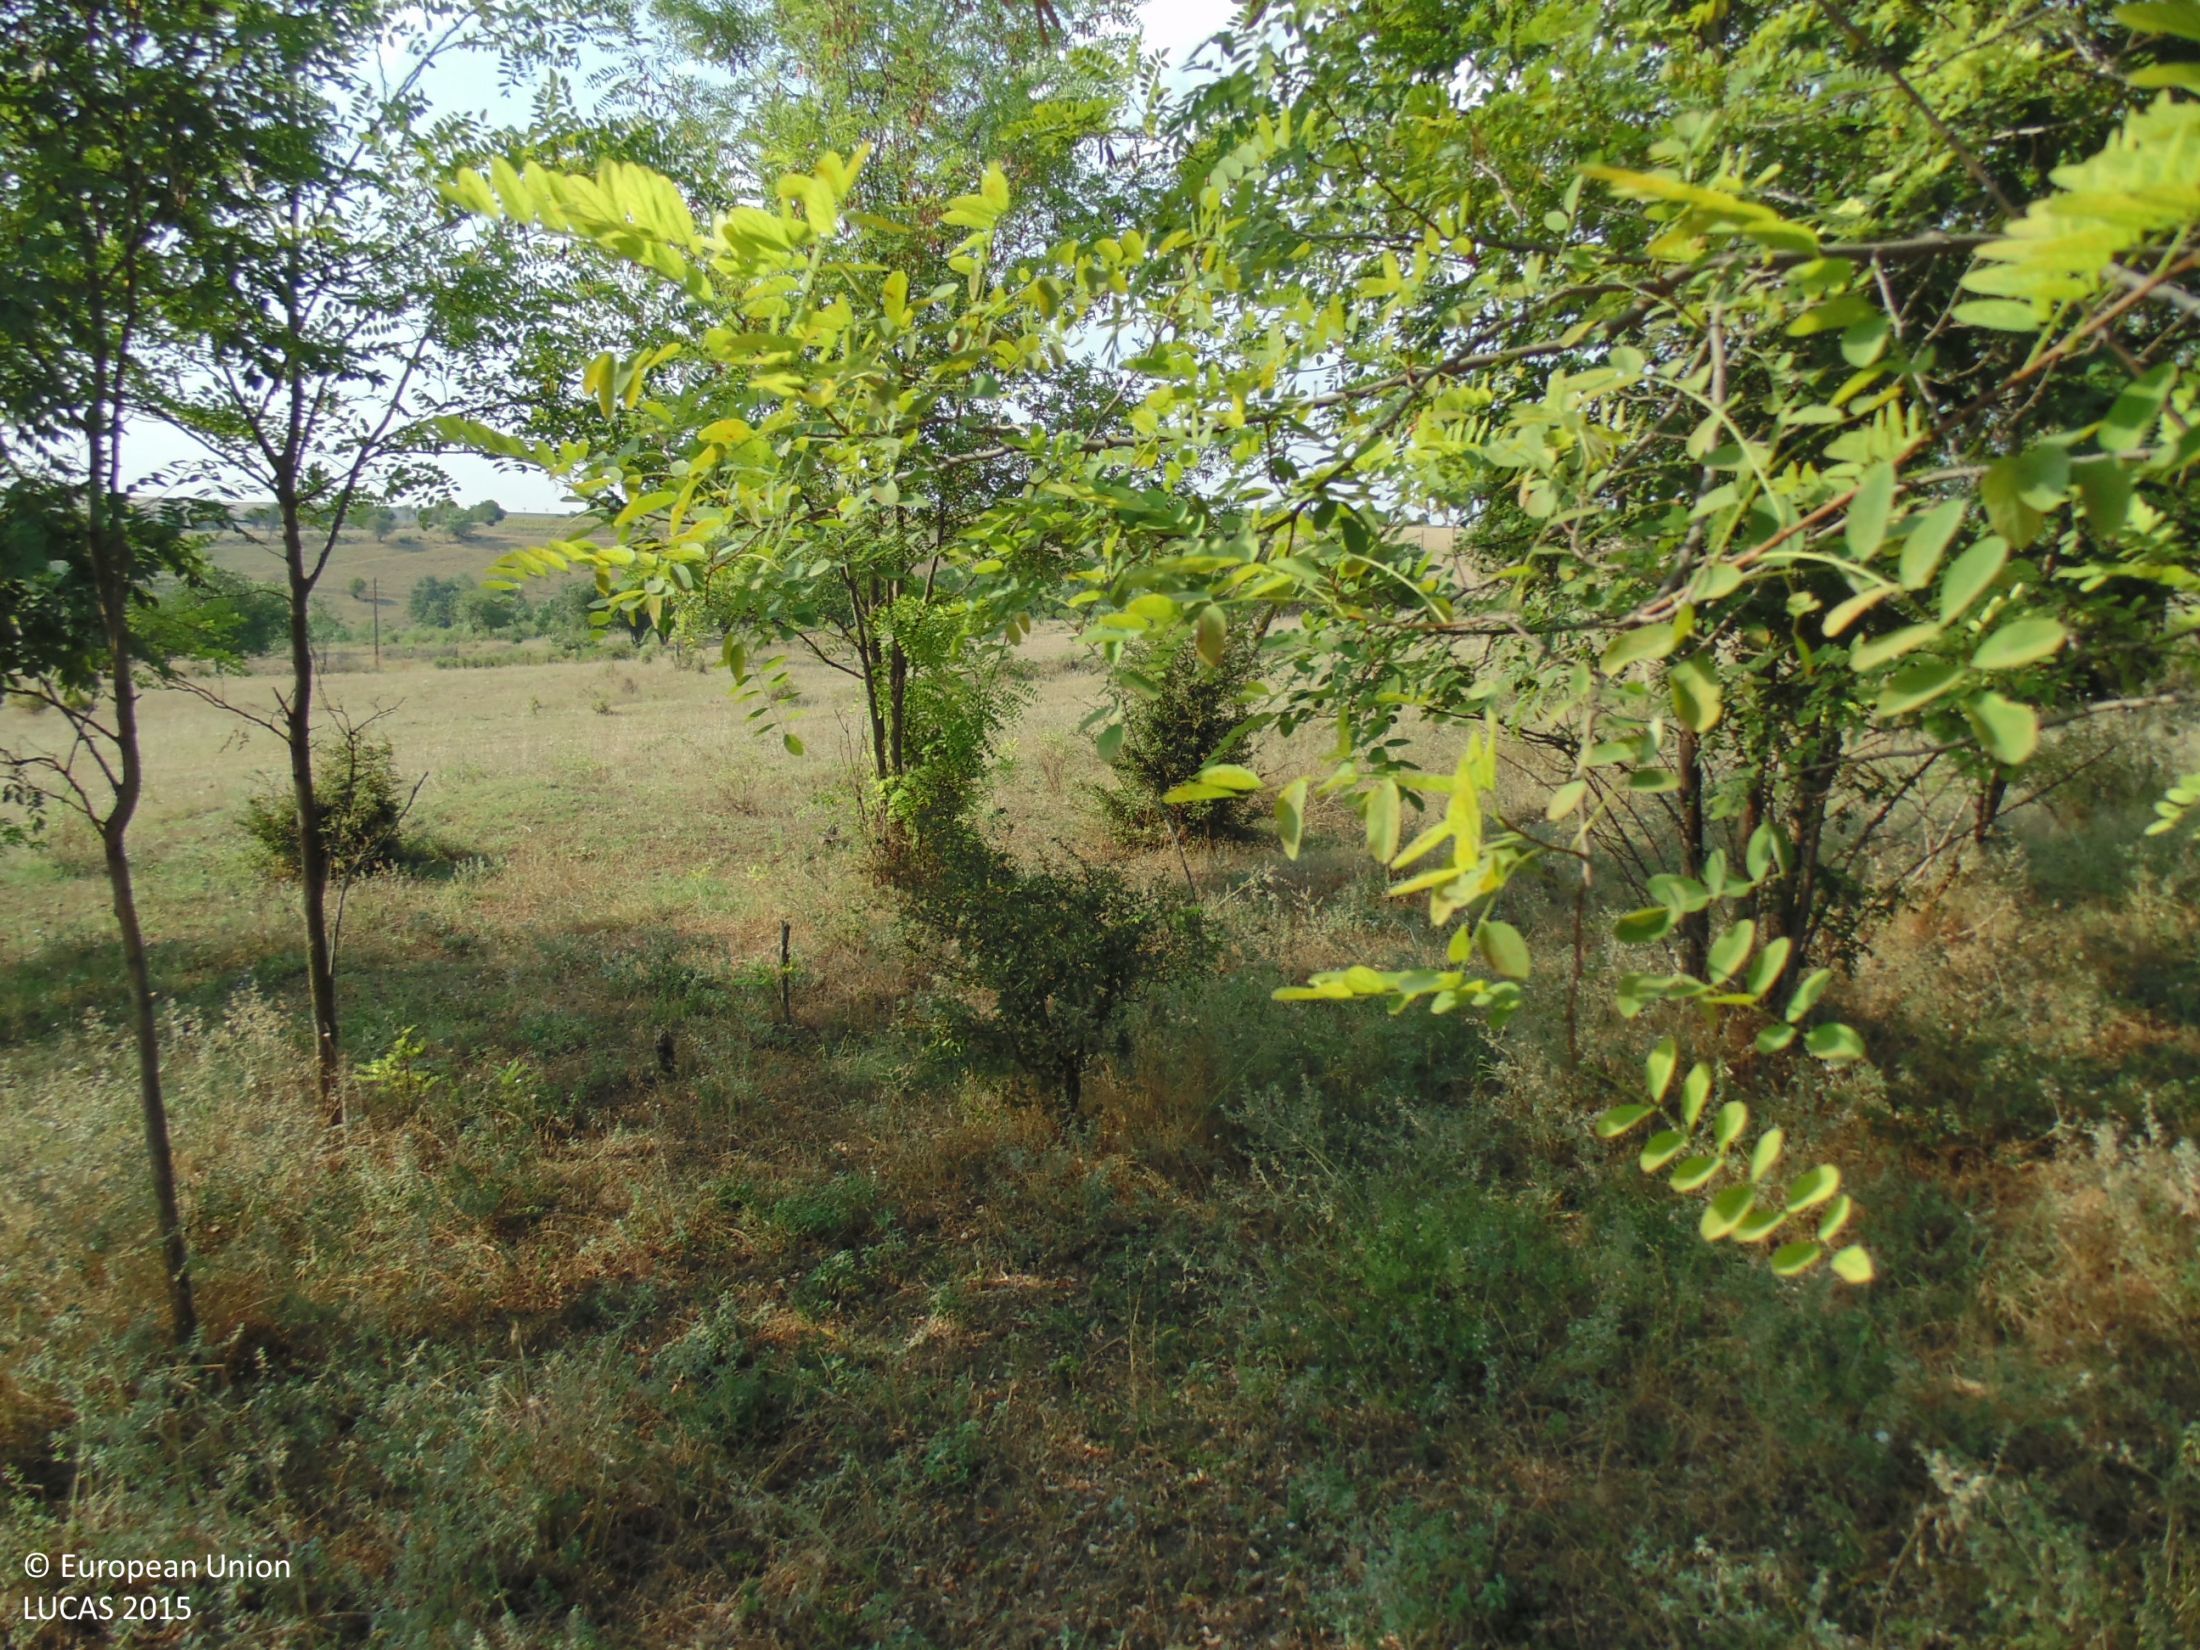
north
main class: Woodland
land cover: Broadleaved woodland
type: mesophytic deciduous forest
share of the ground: > 75 %
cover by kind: broadleaved forest trees 90 %, shrubs 5 %, unconsolidated bare surface 5 %
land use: Forestry
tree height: > 5 m
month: August
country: BG
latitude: 43.9512
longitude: 27.5197
